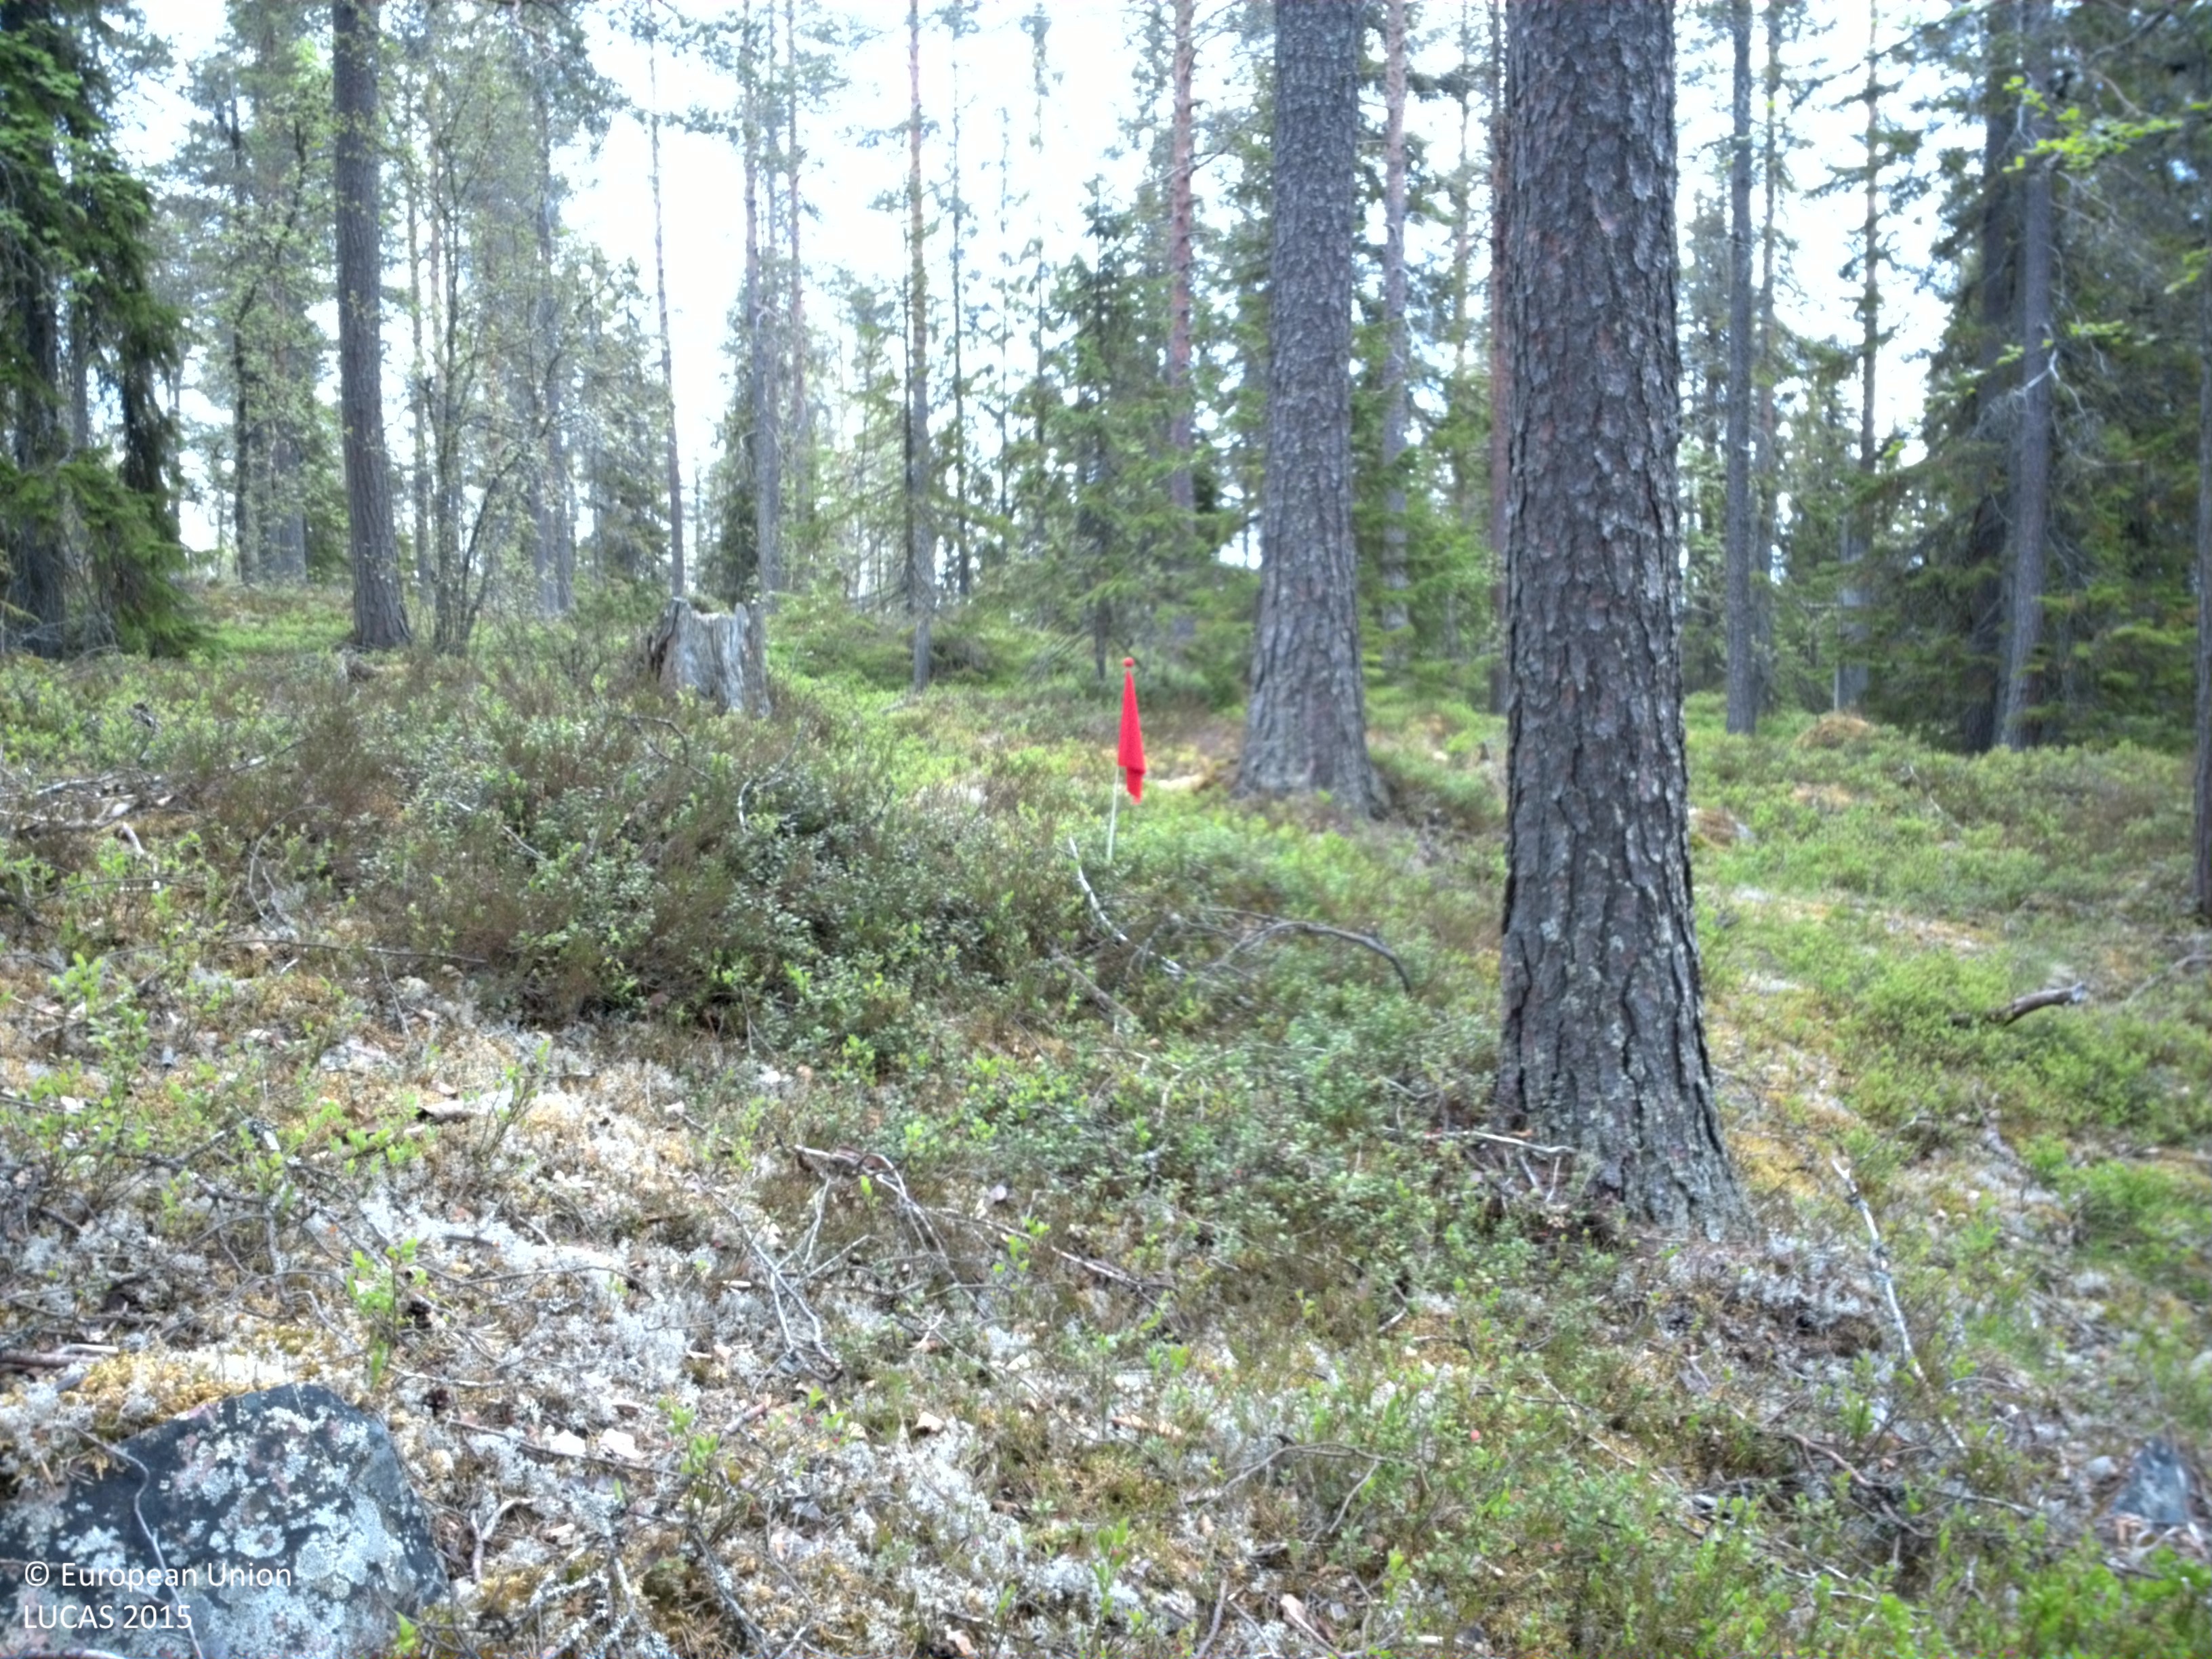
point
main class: Woodland
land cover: Pine dominated mixed woodland
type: boreal forest
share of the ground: 50 - 75 %
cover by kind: coniferous forest trees 45 %, broadleaved forest trees 25 %, shrubs 20 %, lichens and mosses 10 %
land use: Forestry
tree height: > 5 m
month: June
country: SE
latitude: 61.7734
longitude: 13.6819
